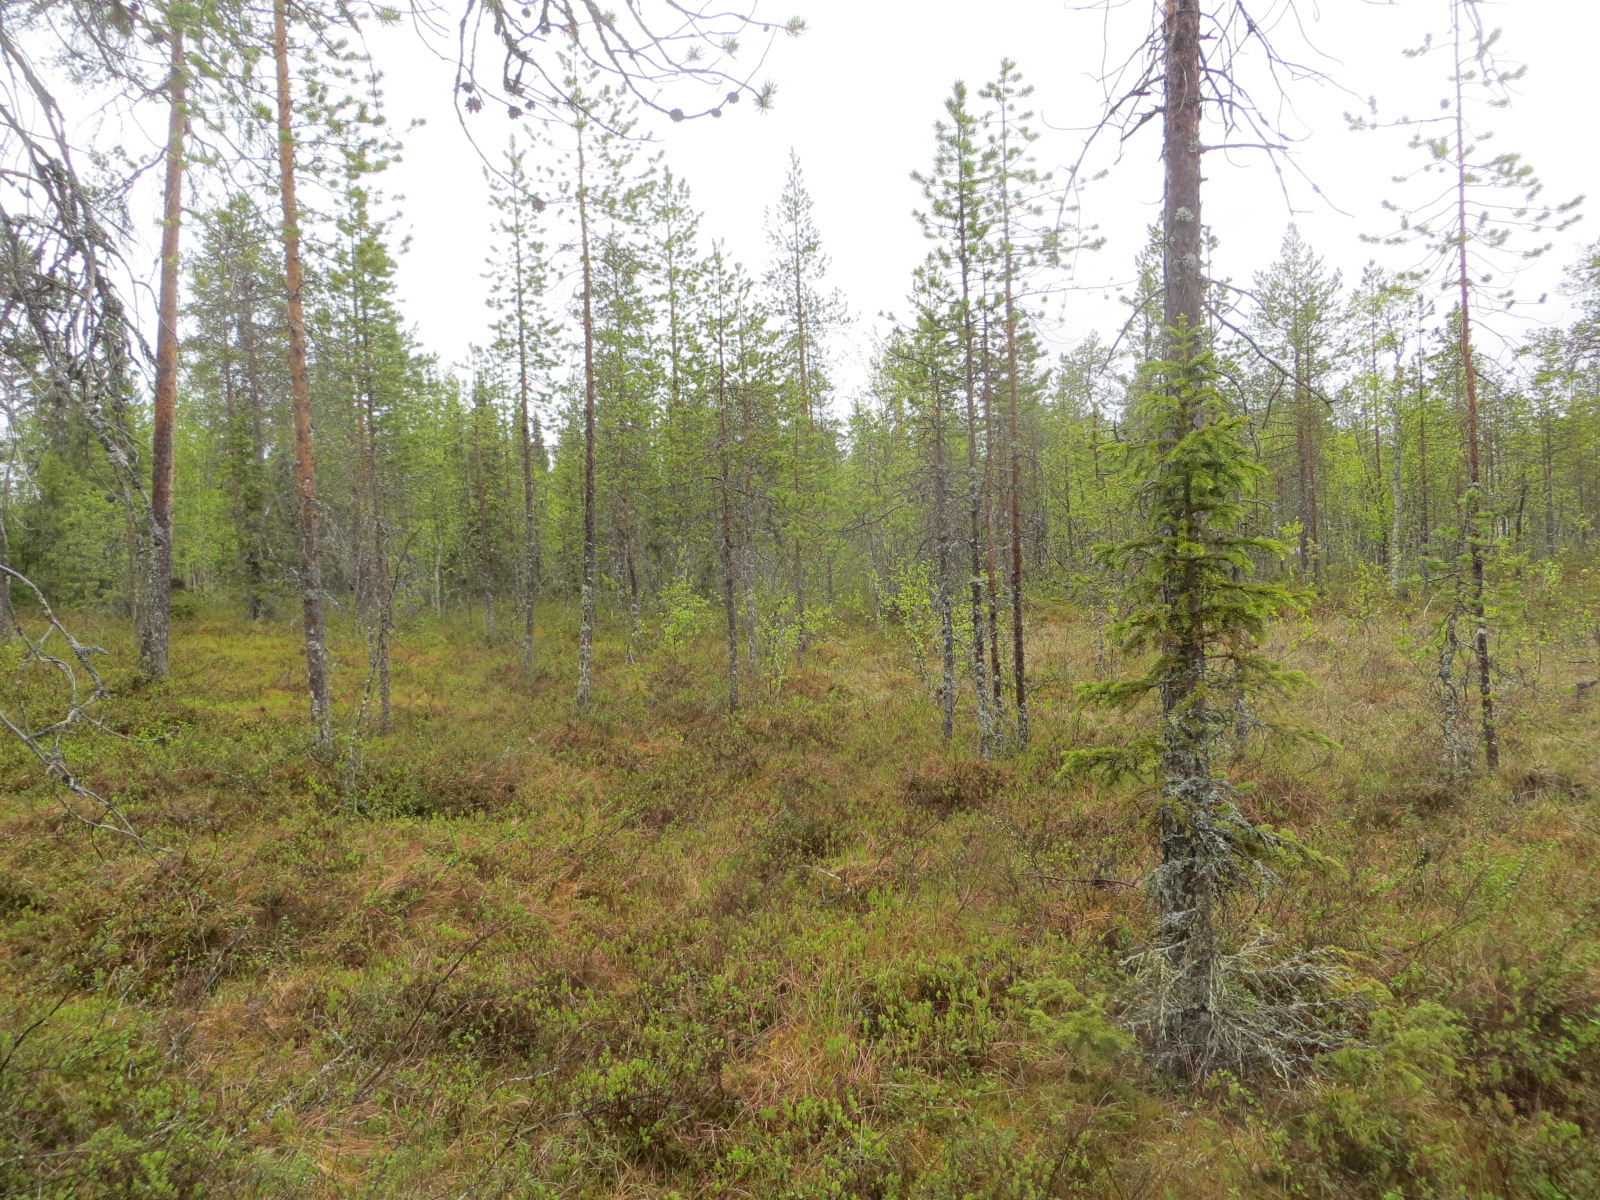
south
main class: Woodland
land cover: Other mixed woodland
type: boreal forest
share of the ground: > 75 %
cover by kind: coniferous forest trees 50 %, broadleaved forest trees 25 %, shrubs 10 %, herbaceous plants 10 %, lichens and mosses 5 %
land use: Forestry
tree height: > 5 m
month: June
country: FI
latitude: 67.2546
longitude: 25.5596
